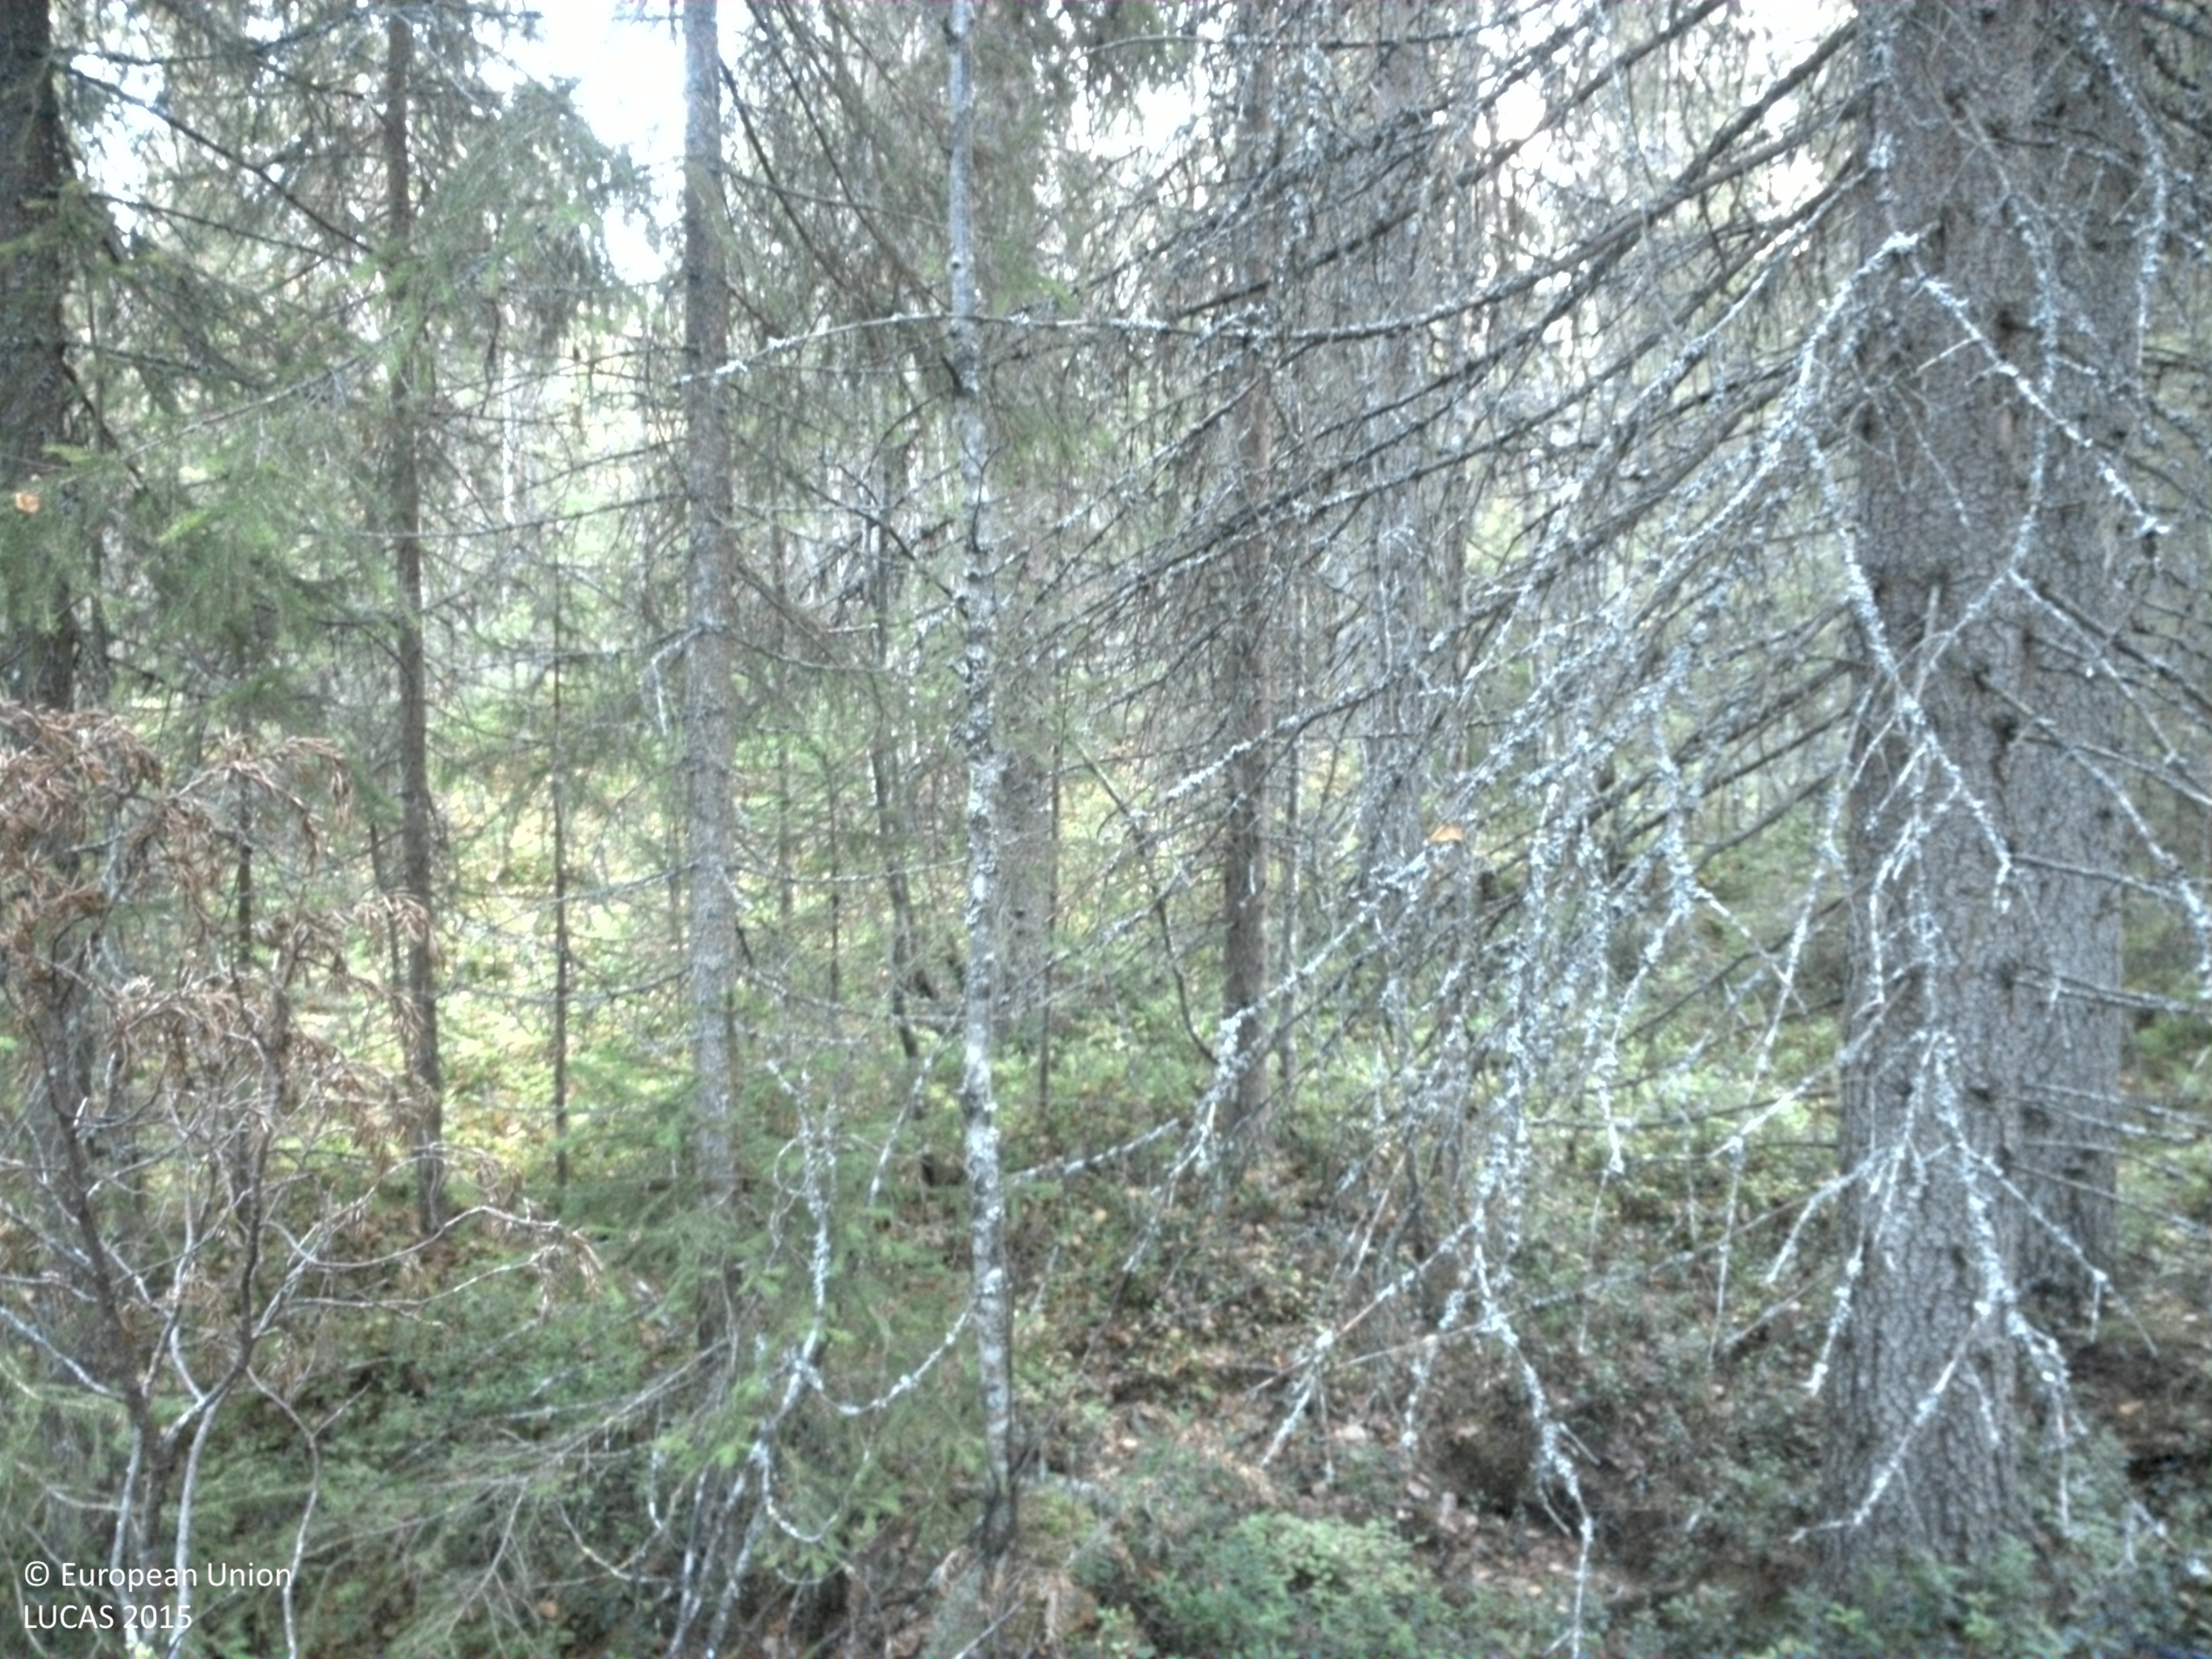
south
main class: Woodland
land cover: Spruce dominated coniferous woodland
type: boreal forest
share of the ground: 50 - 75 %
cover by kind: coniferous forest trees 45 %, shrubs 25 %, lichens and mosses 20 %, broadleaved forest trees 10 %
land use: Forestry
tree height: > 5 m
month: October
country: SE
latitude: 64.8026
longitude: 17.4804
